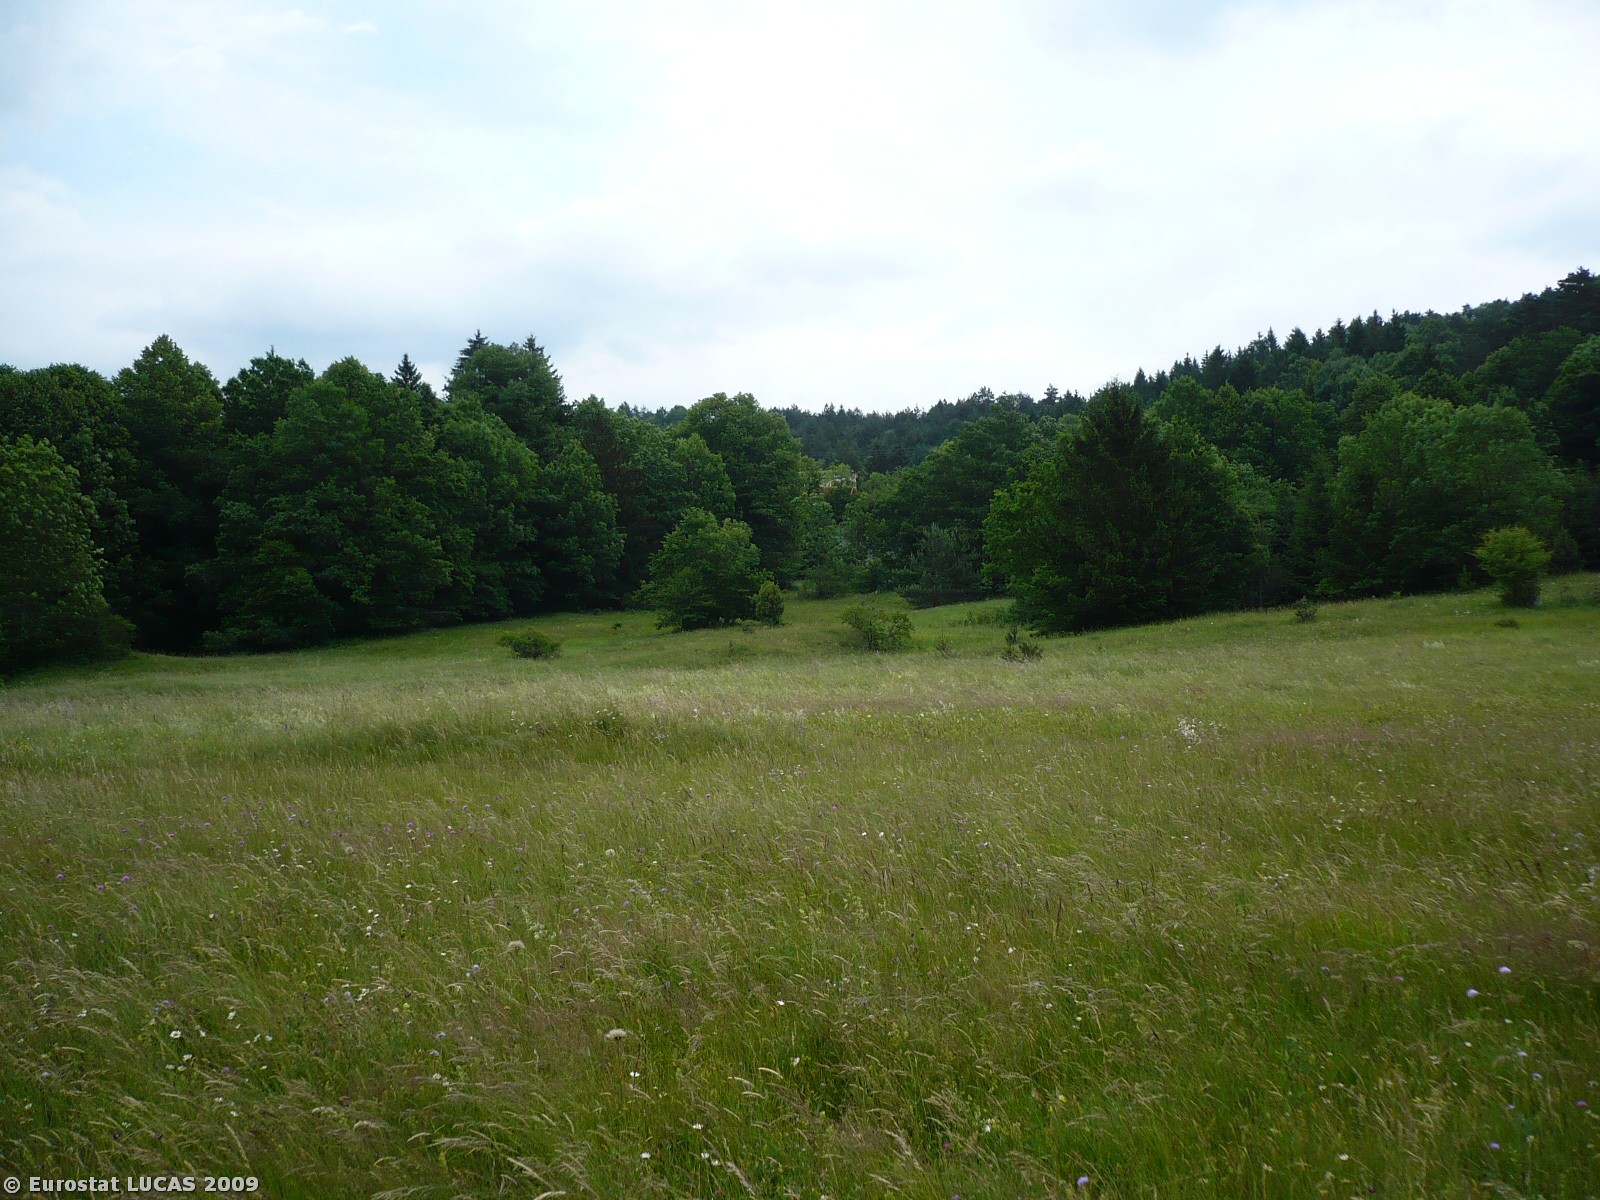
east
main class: Grassland
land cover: Grassland without tree/shrub cover
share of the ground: > 75 %
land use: Agriculture (excluding fallow land and kitchen gardens)
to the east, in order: Grassland without tree/shrub cover; Grassland with sparse tree/shrub cover; Spontaneously vegetated surfaces; Grassland with sparse tree/shrub cover; Paved roads, cycling and walking lanes; Grassland with sparse tree/shrub cover; Broadleaved woodland; Grassland with sparse tree/shrub cover; Broadleaved woodland; Bare land; Railways
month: June
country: SI
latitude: 45.7457
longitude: 14.1989
